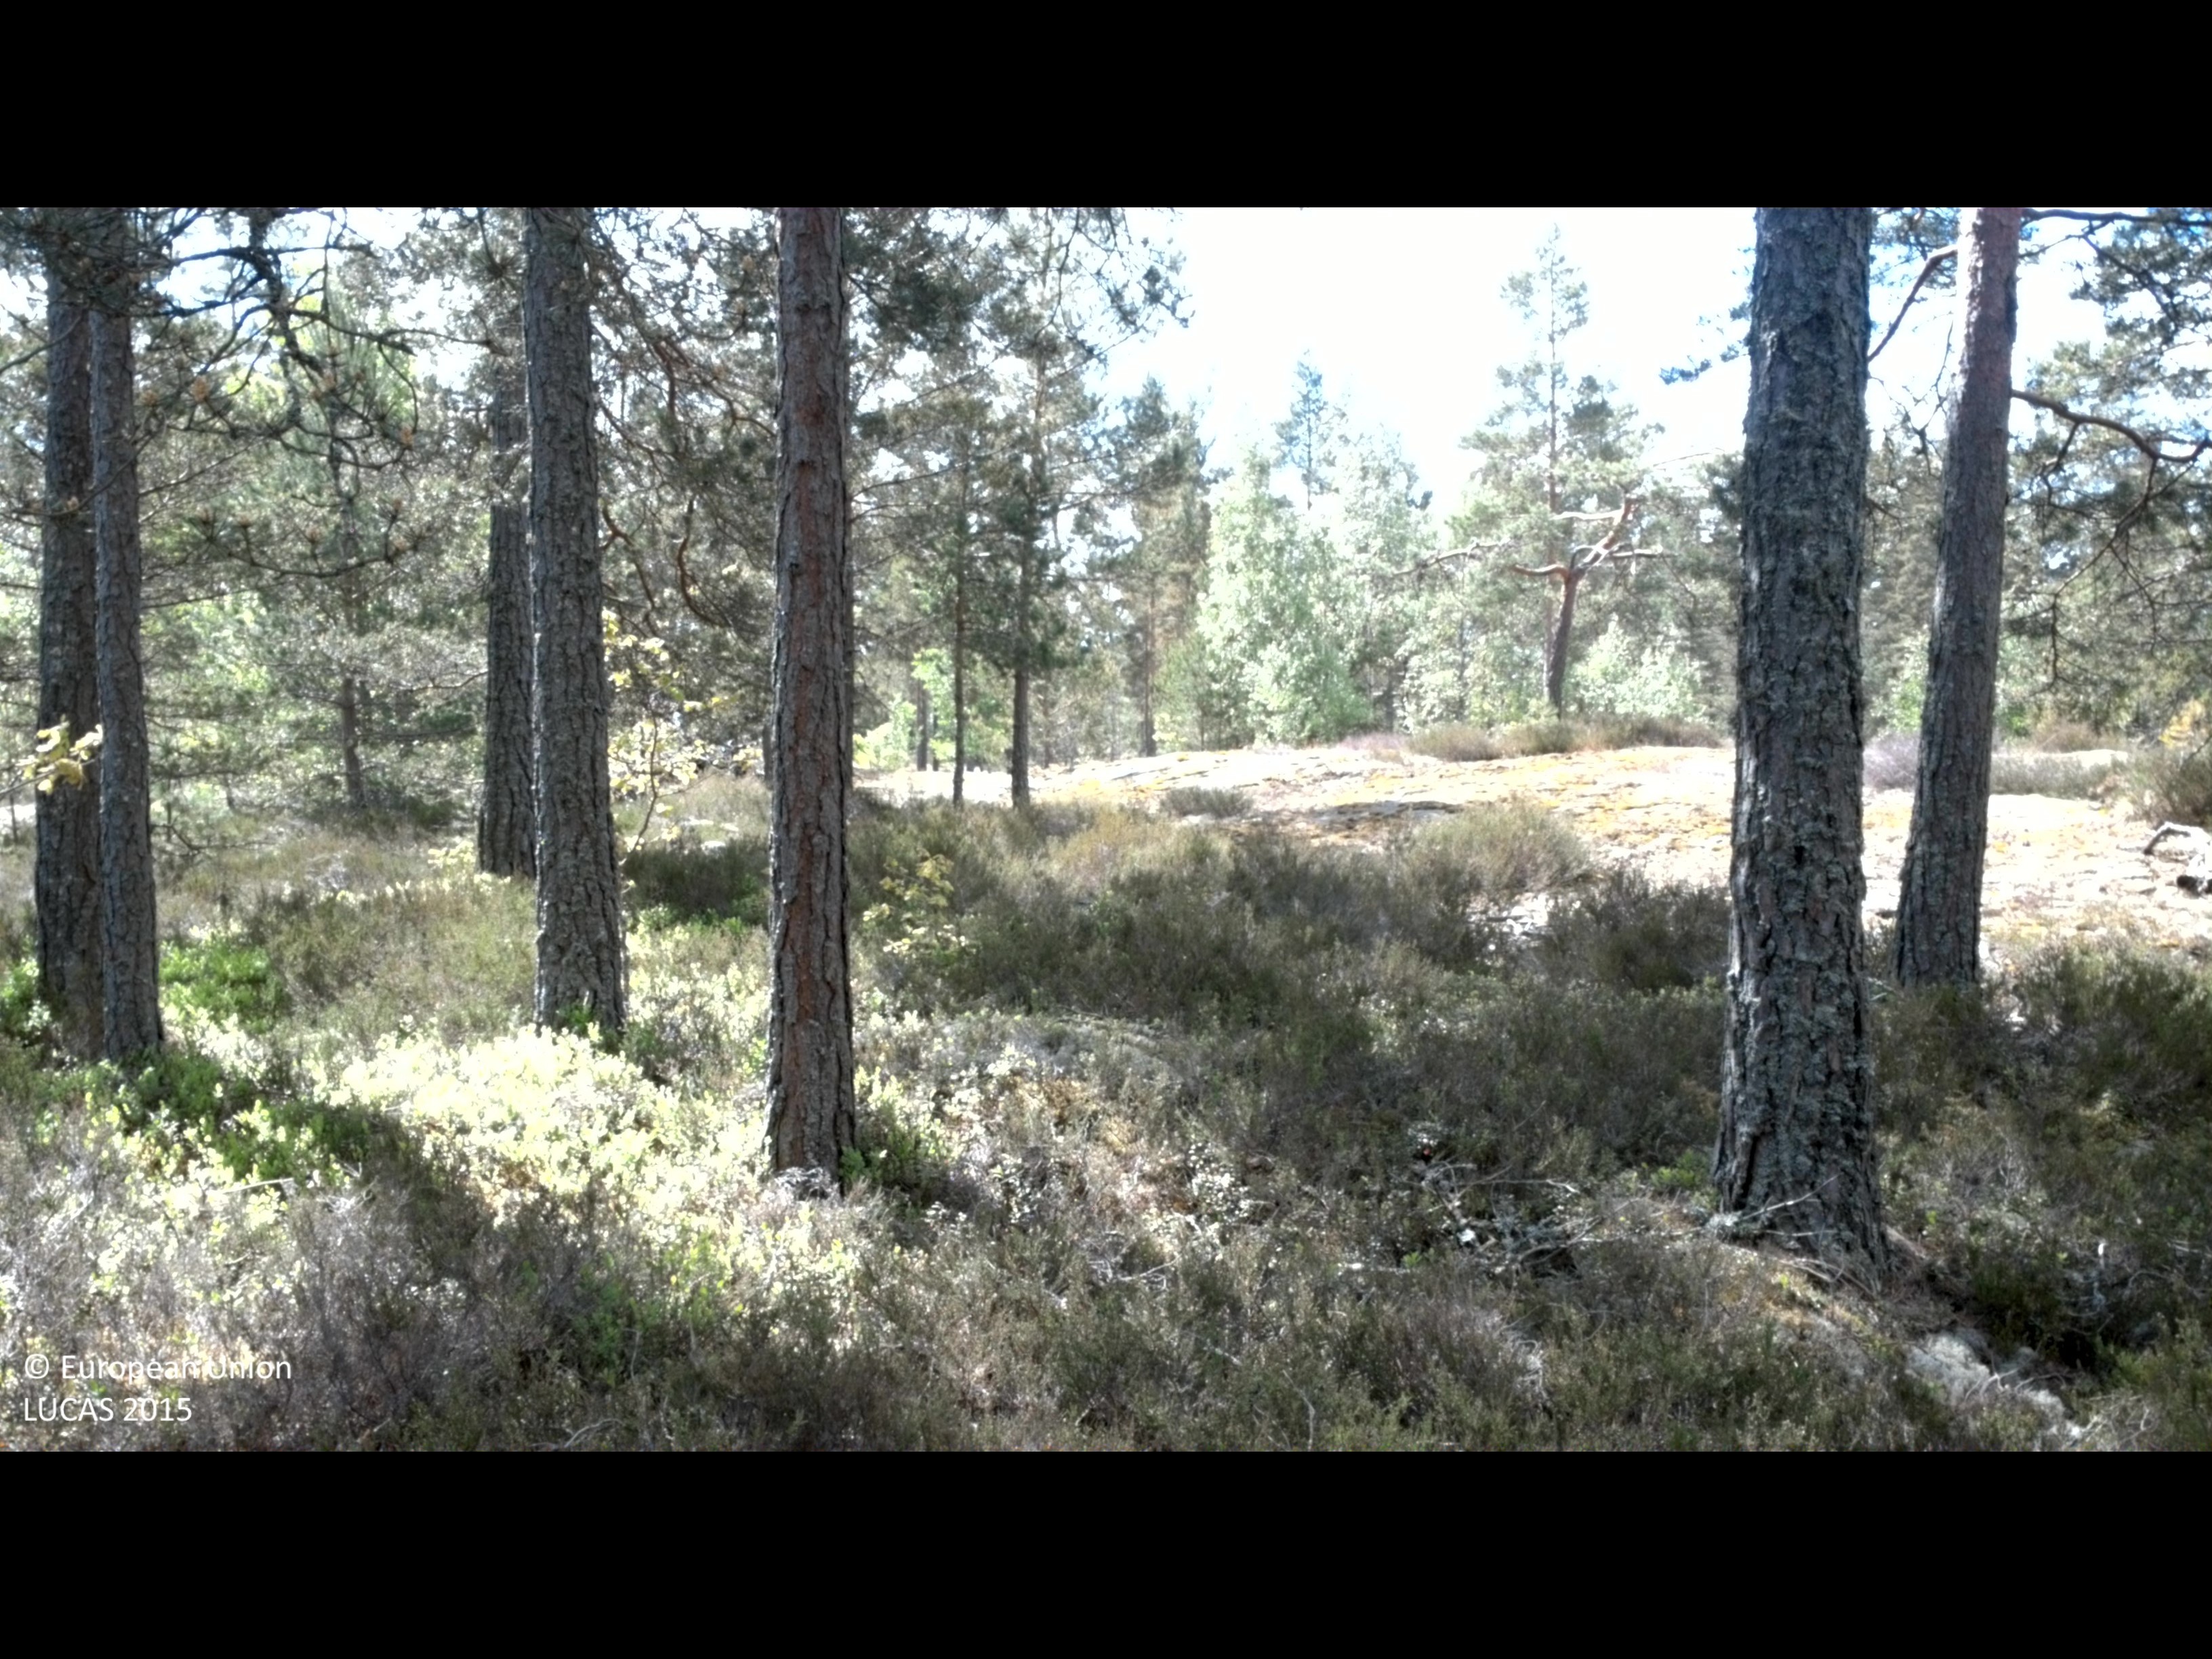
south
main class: Woodland
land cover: Pine dominated coniferous woodland
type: boreal forest
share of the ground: 50 - 75 %
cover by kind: coniferous forest trees 65 %, shrubs 15 %, lichens and mosses 15 %, broadleaved forest trees 5 %
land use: Forestry
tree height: > 5 m
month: May
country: SE
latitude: 57.5340
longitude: 16.5970
